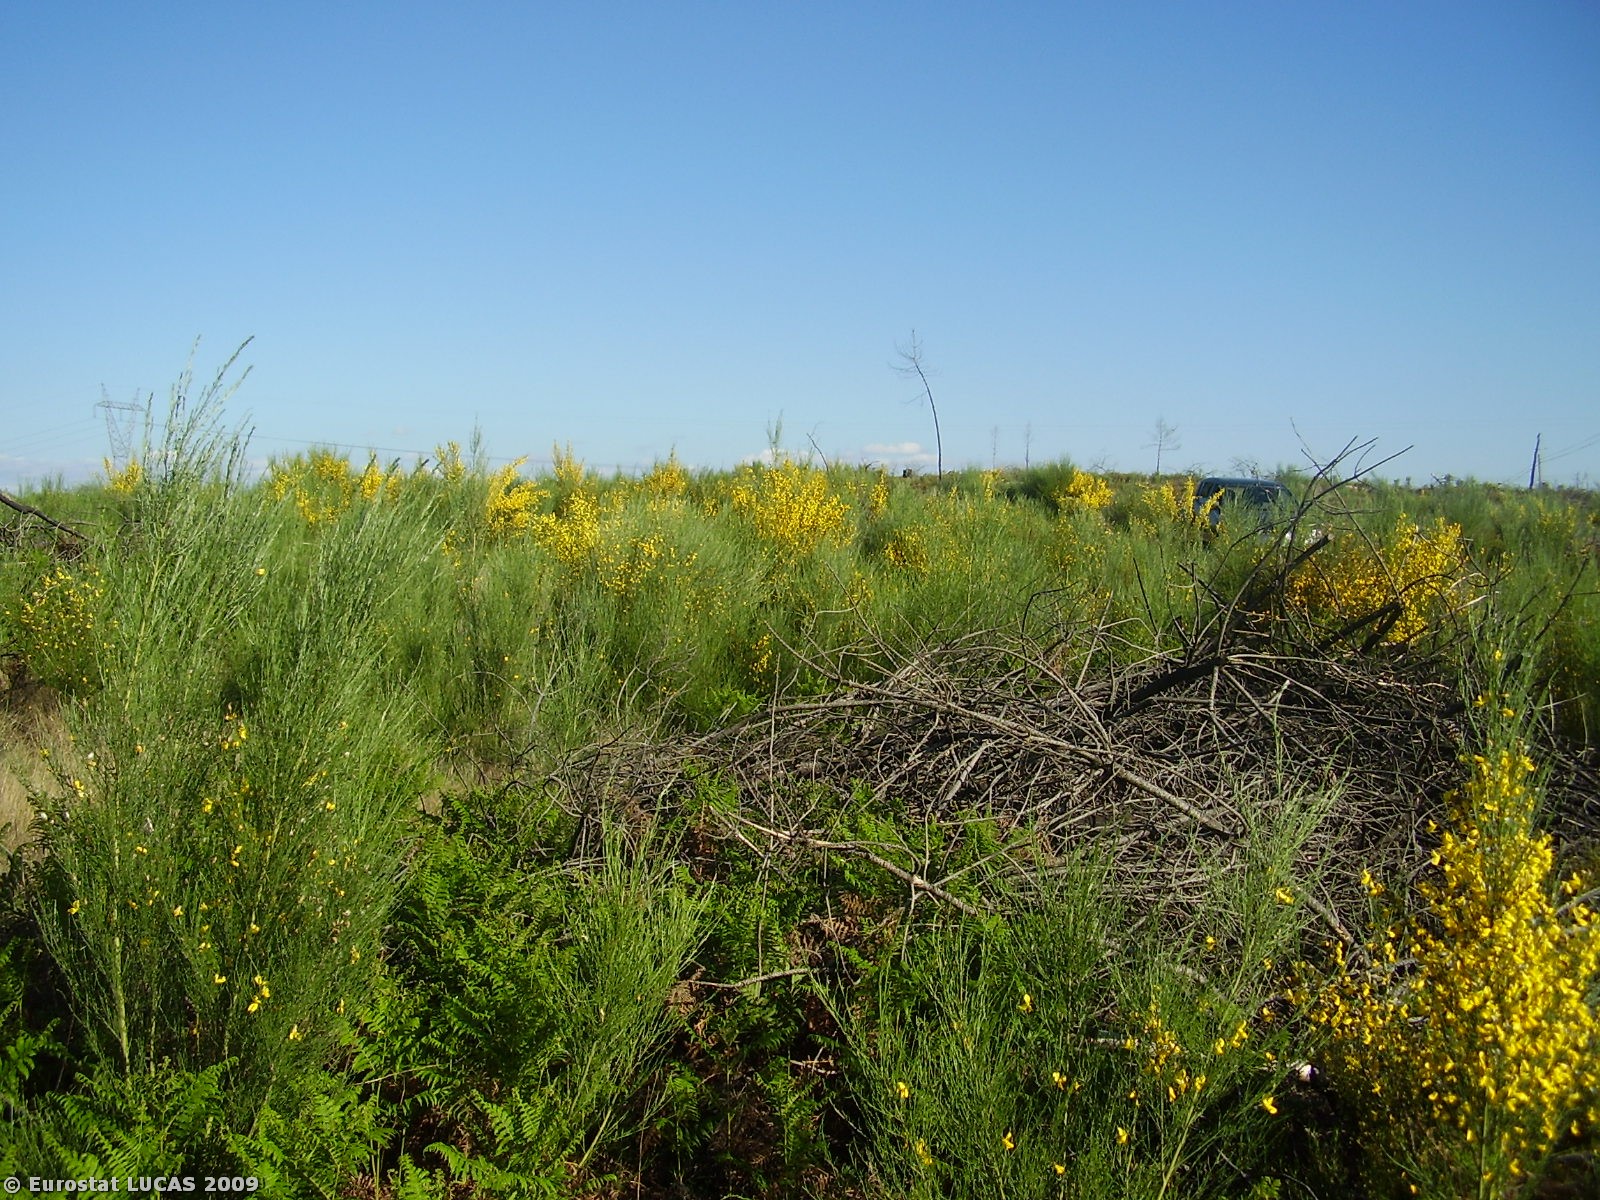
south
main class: Shrubland
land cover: Shrubland without tree cover
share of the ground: > 75 %
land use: Unused
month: May
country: PT
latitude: 41.2542
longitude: -7.2427
